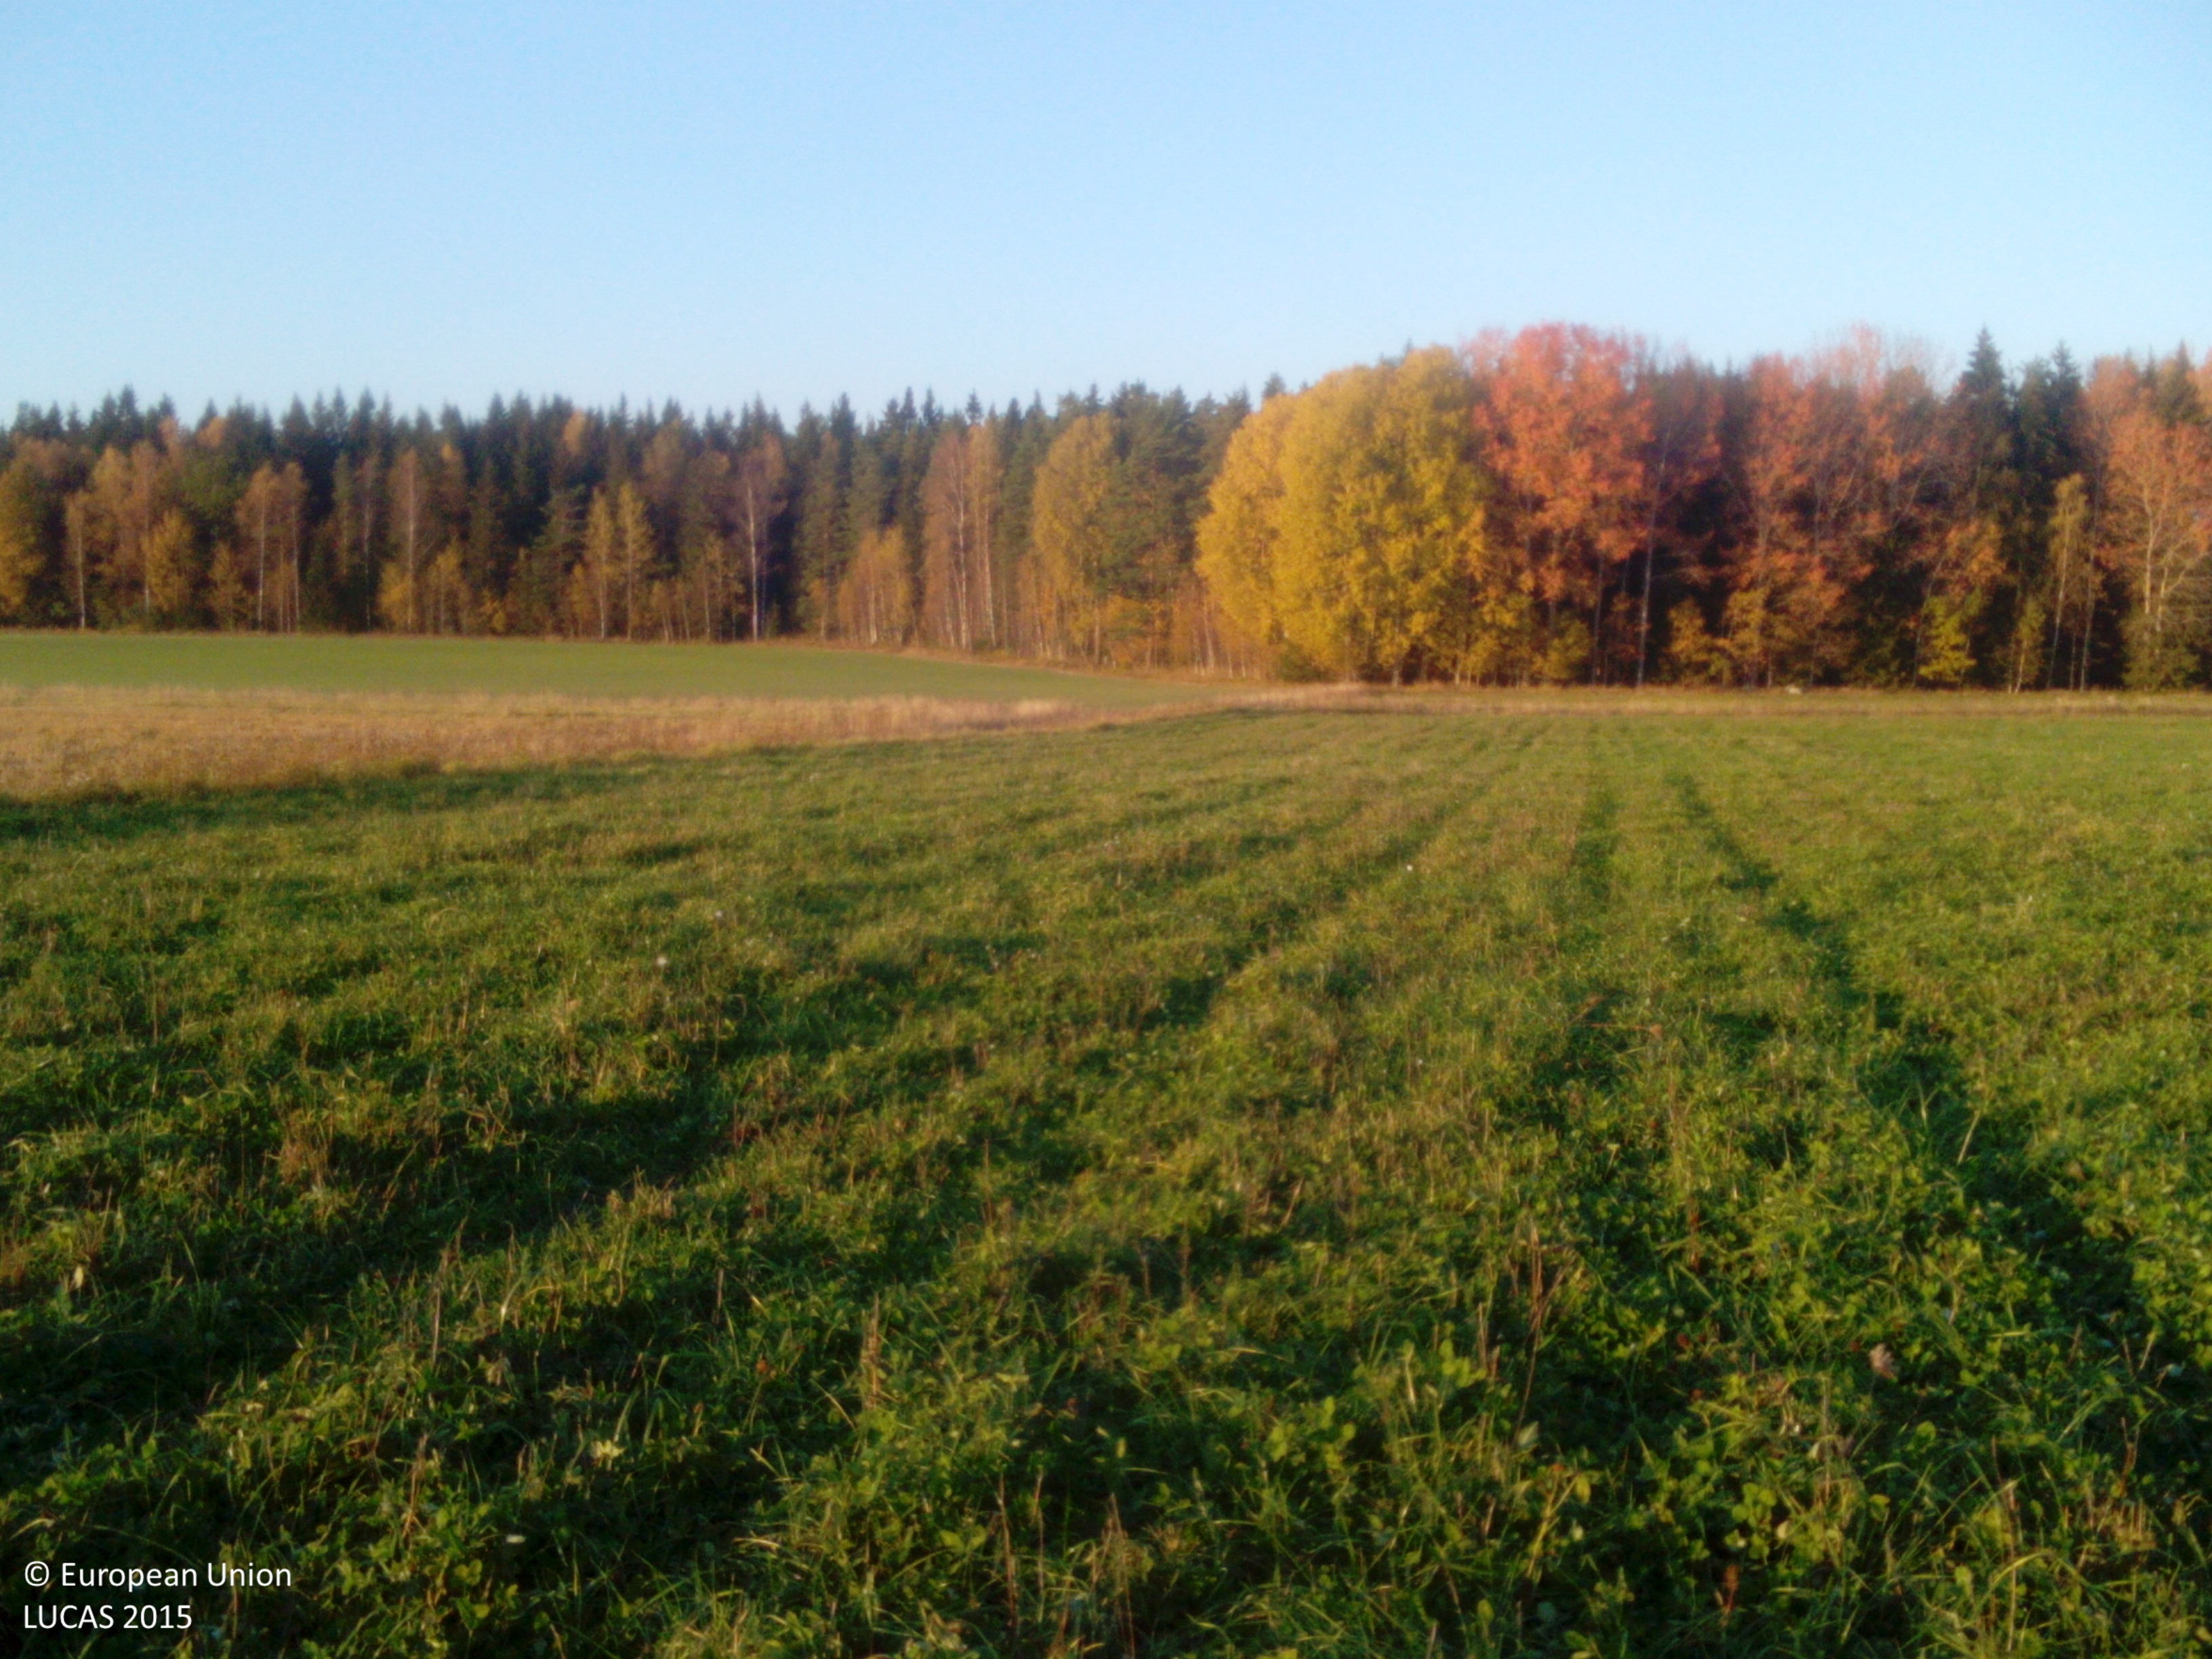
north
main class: Cropland
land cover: Clovers
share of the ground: > 75 %
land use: Agriculture (excluding fallow land and kitchen gardens)
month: October
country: SE
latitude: 58.8797
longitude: 16.3956
